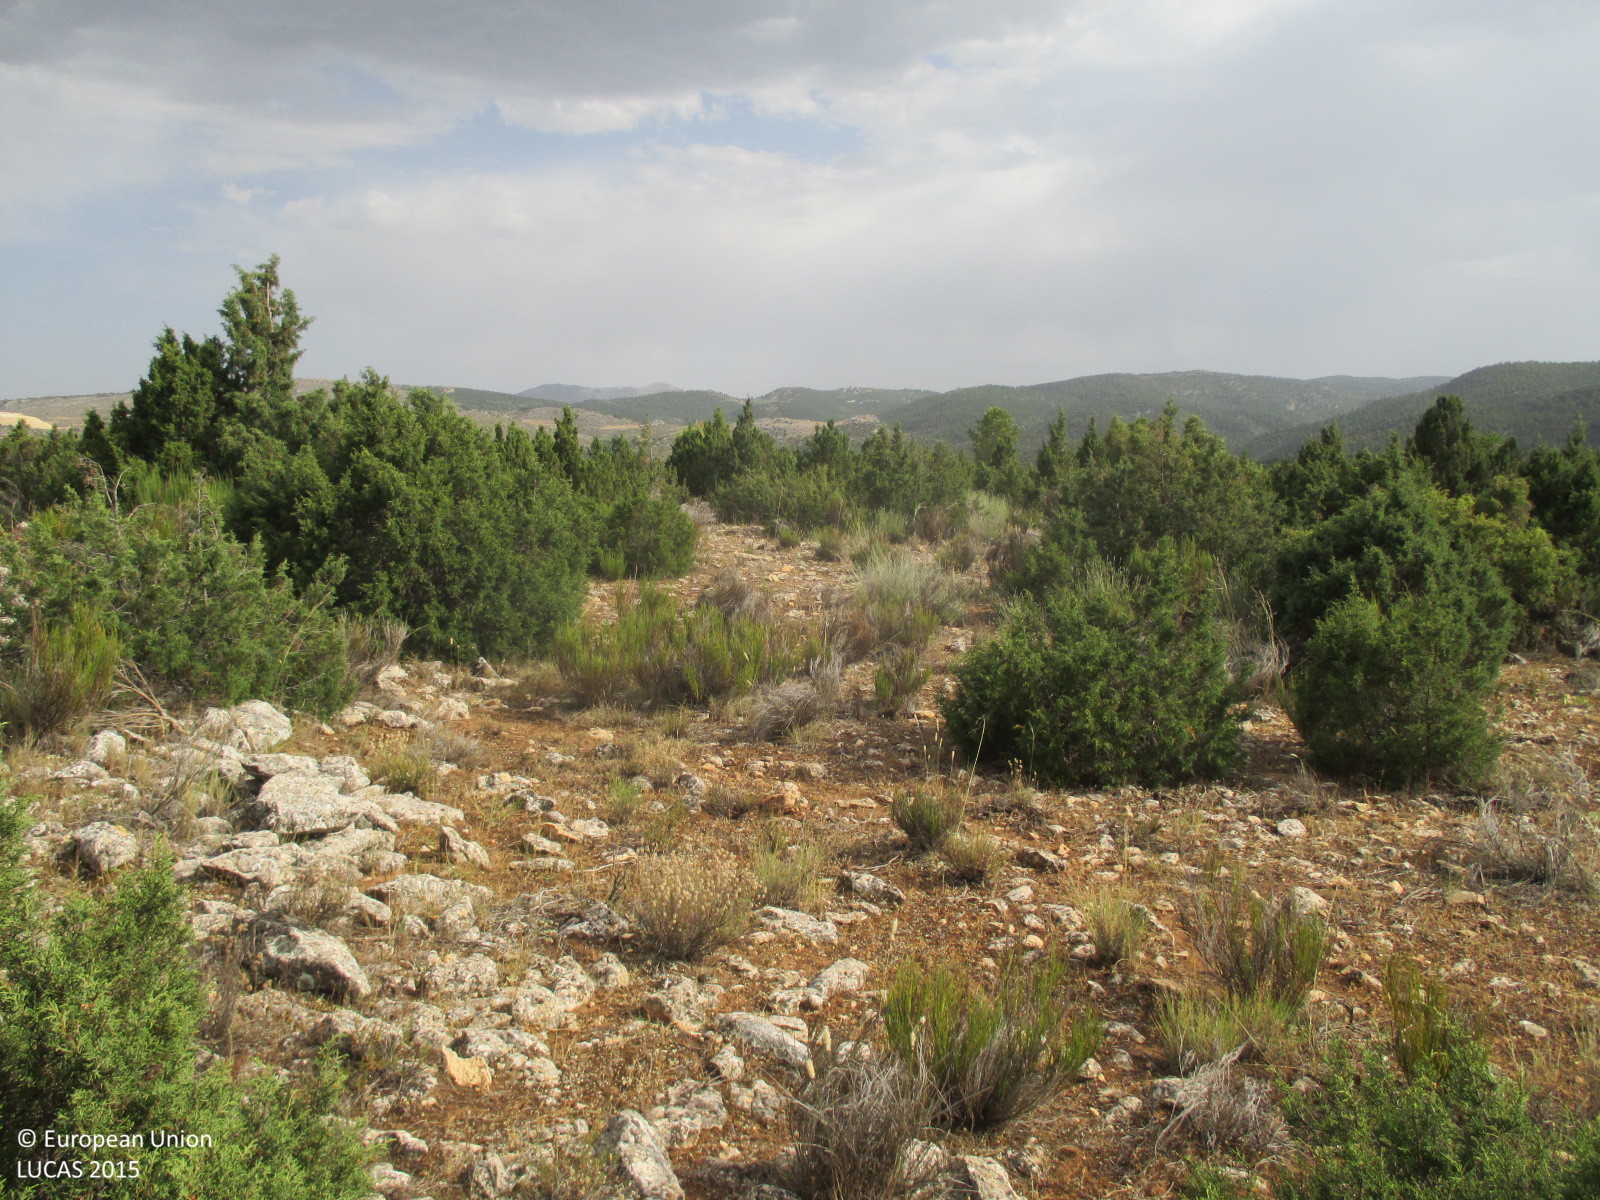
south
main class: Shrubland
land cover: Shrubland without tree cover
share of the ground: 50 - 75 %
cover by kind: shrubs 50 %, herbaceous plants 30 %, consolidated bare surface 20 %
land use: Semi-natural and natural areas not in use
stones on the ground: < 10 %
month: July
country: ES
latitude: 38.1929
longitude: -2.4285
